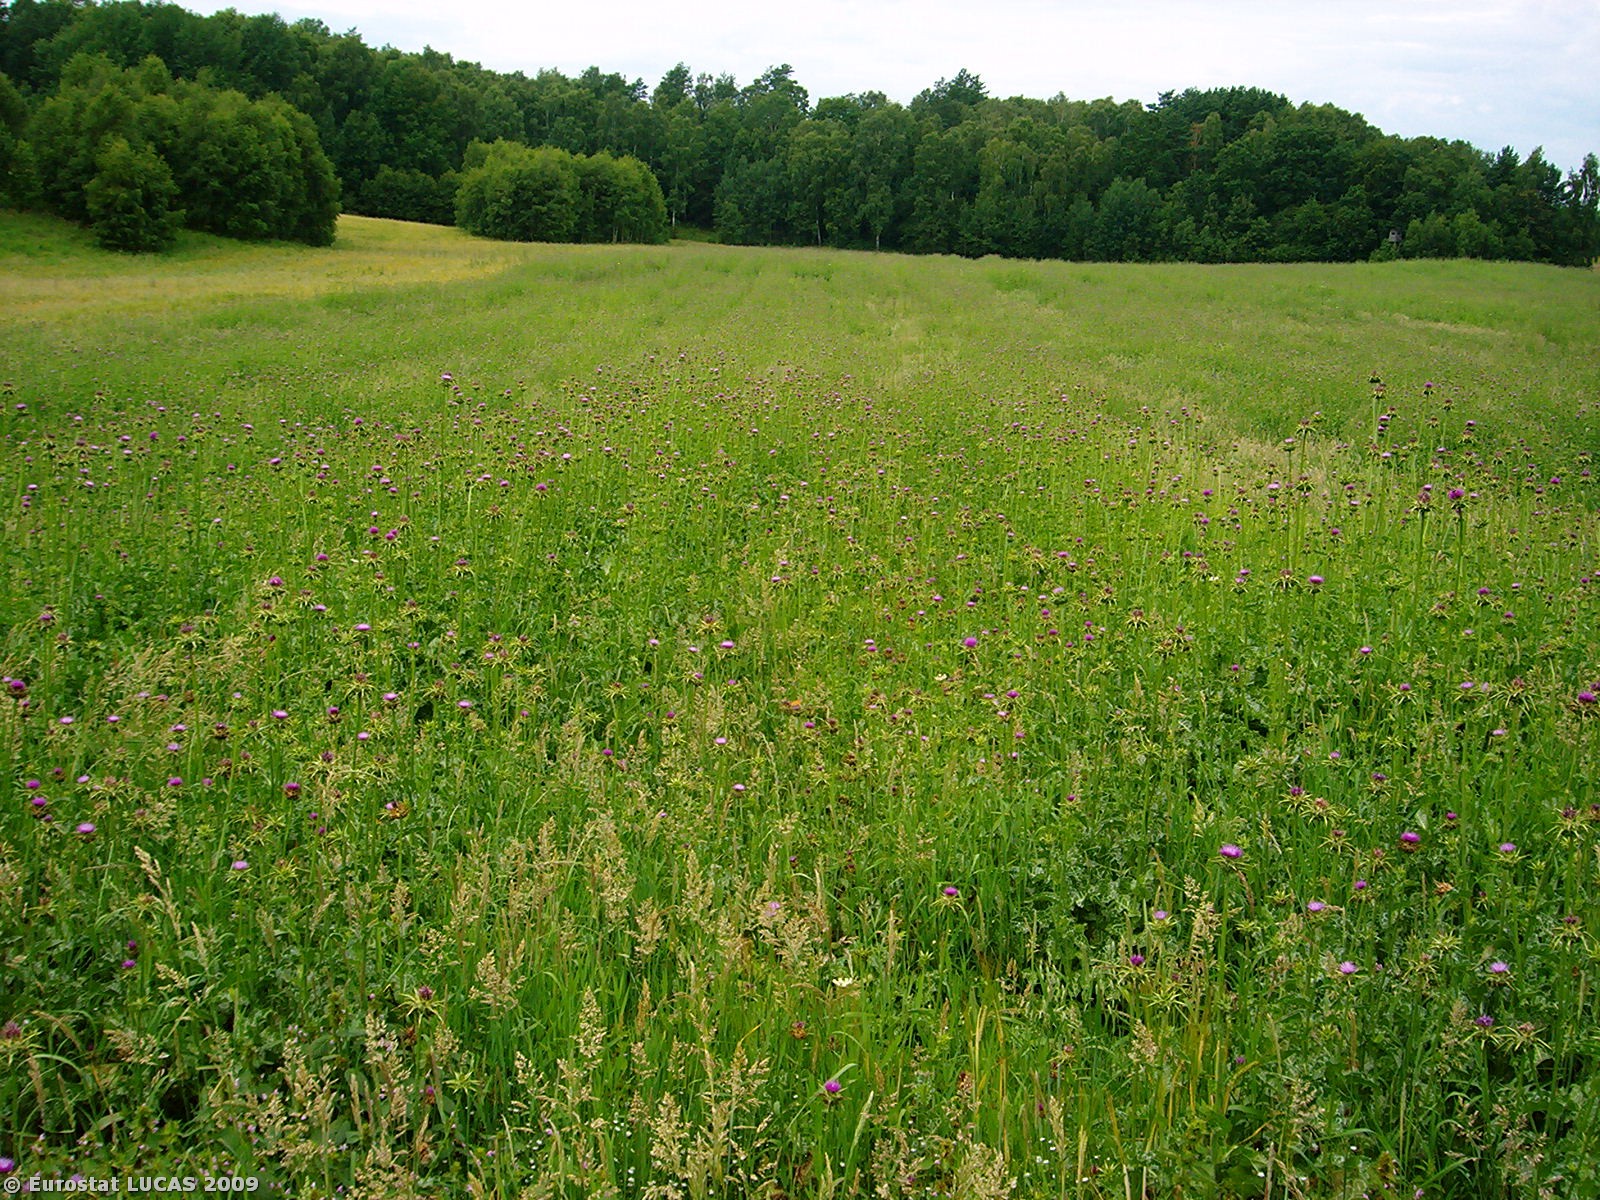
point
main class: Cropland
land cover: Other leguminous and mixtures for fodder
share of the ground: > 75 %
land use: Agriculture (excluding fallow land and kitchen gardens)
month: July
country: PL
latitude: 52.3823
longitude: 15.3660
